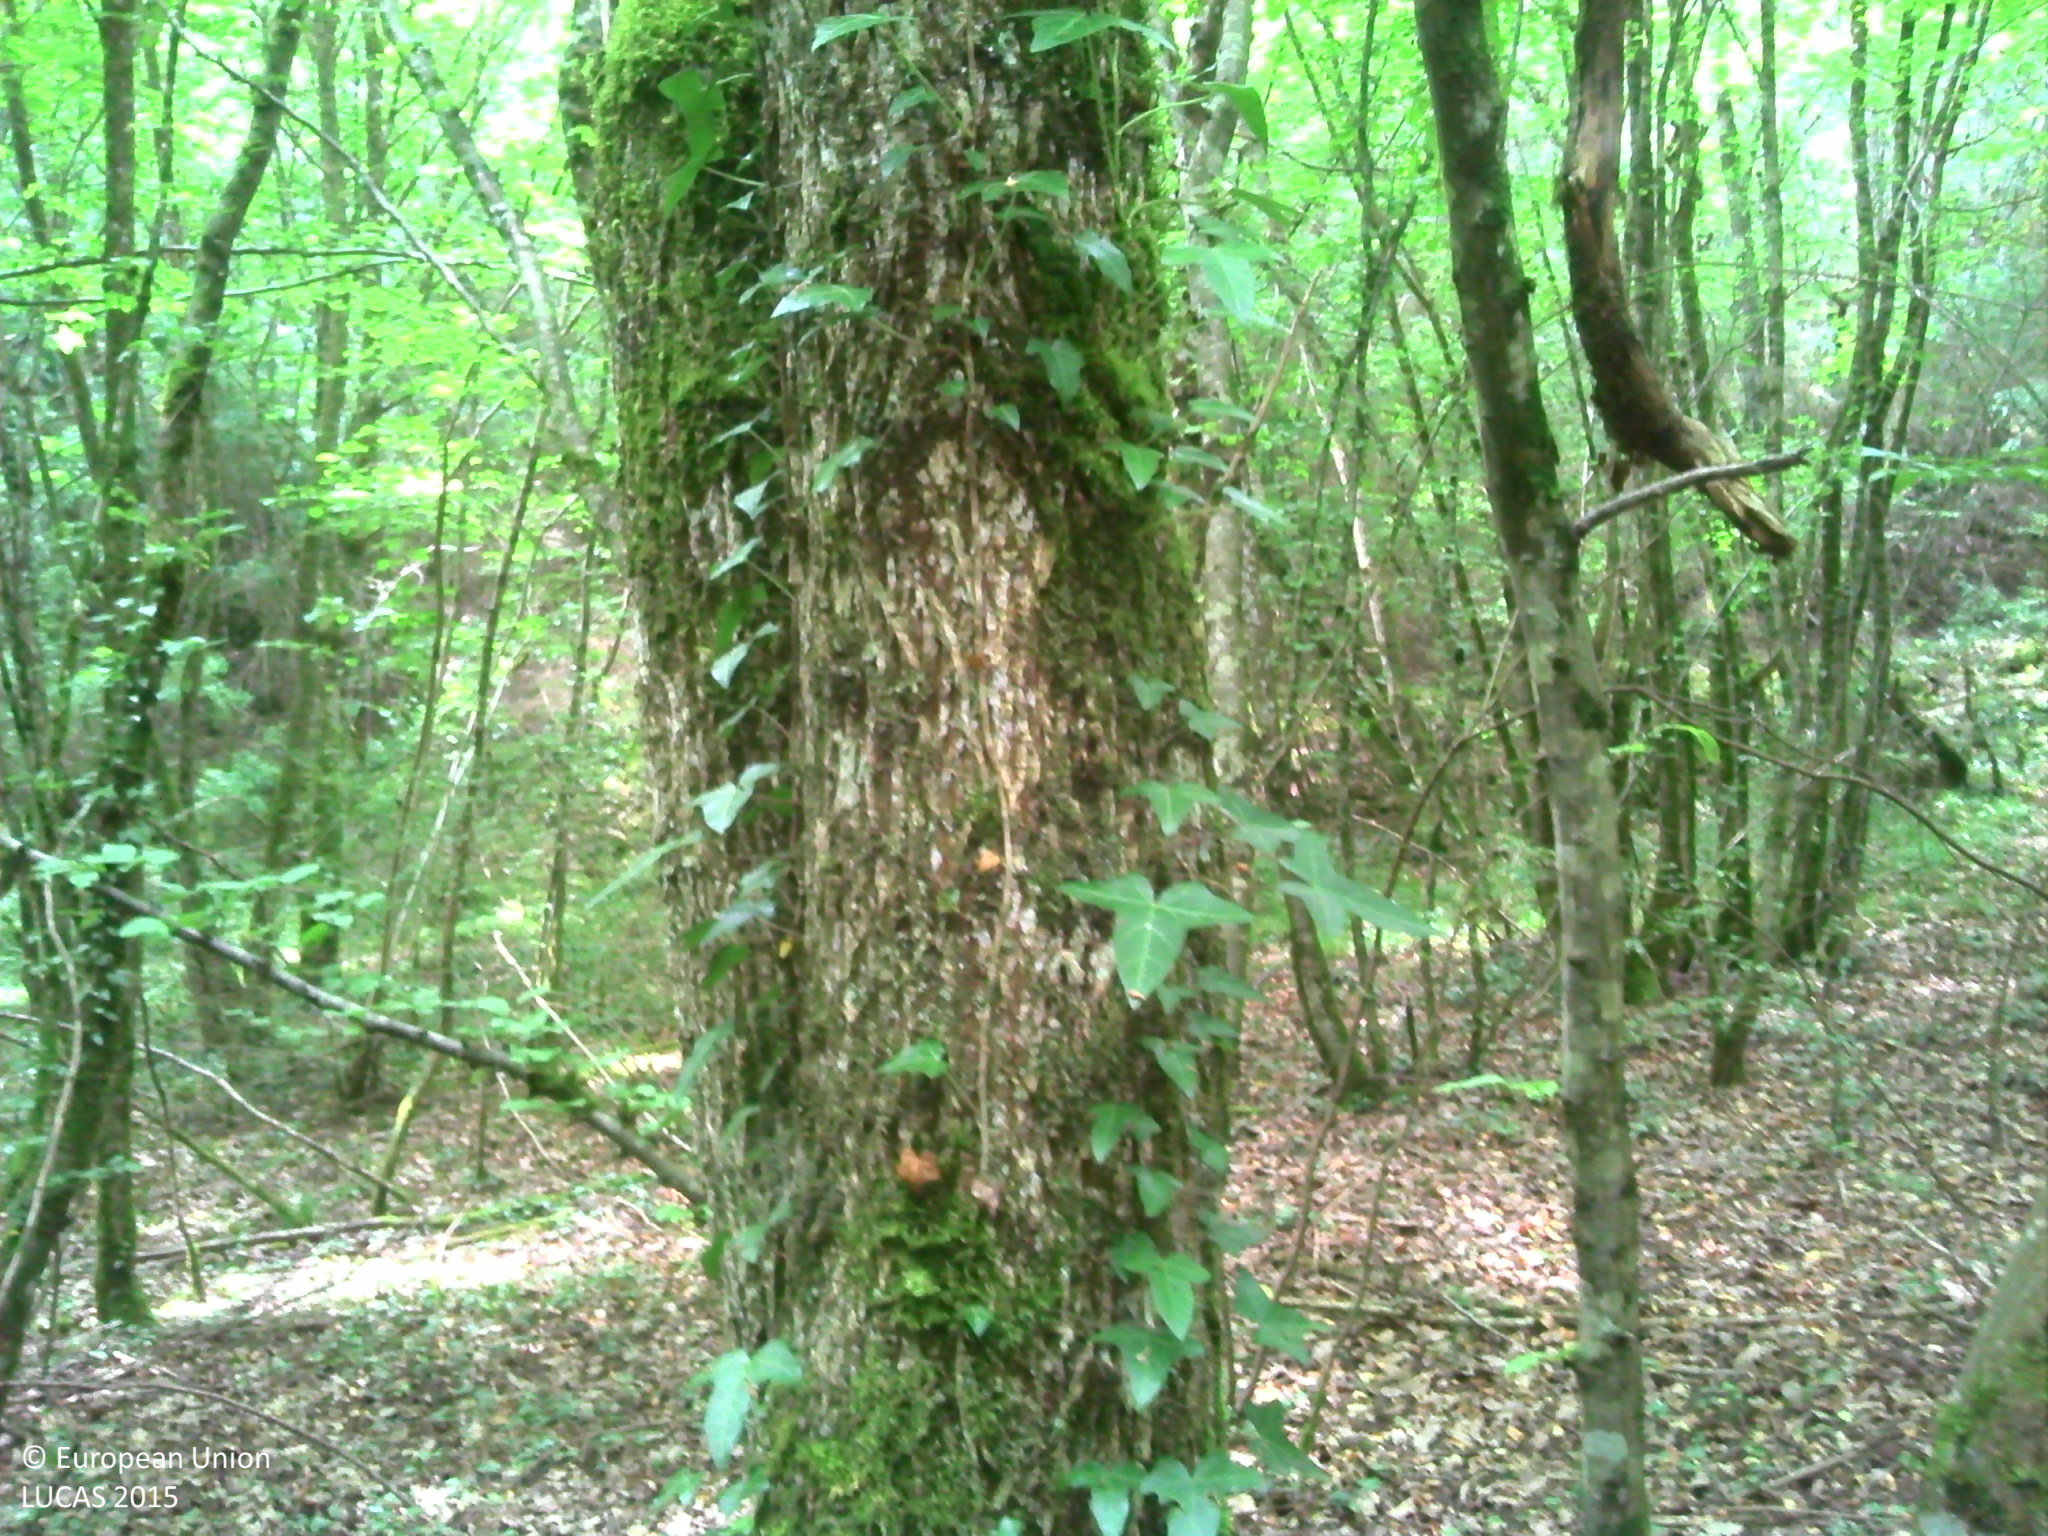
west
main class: Woodland
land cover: Broadleaved woodland
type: mesophytic deciduous forest
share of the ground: > 75 %
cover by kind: broadleaved forest trees 60 %, herbaceous plants 35 %, lichens and mosses 5 %
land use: Forestry
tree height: > 5 m
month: June
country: FR
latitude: 46.5687
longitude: 4.8222
